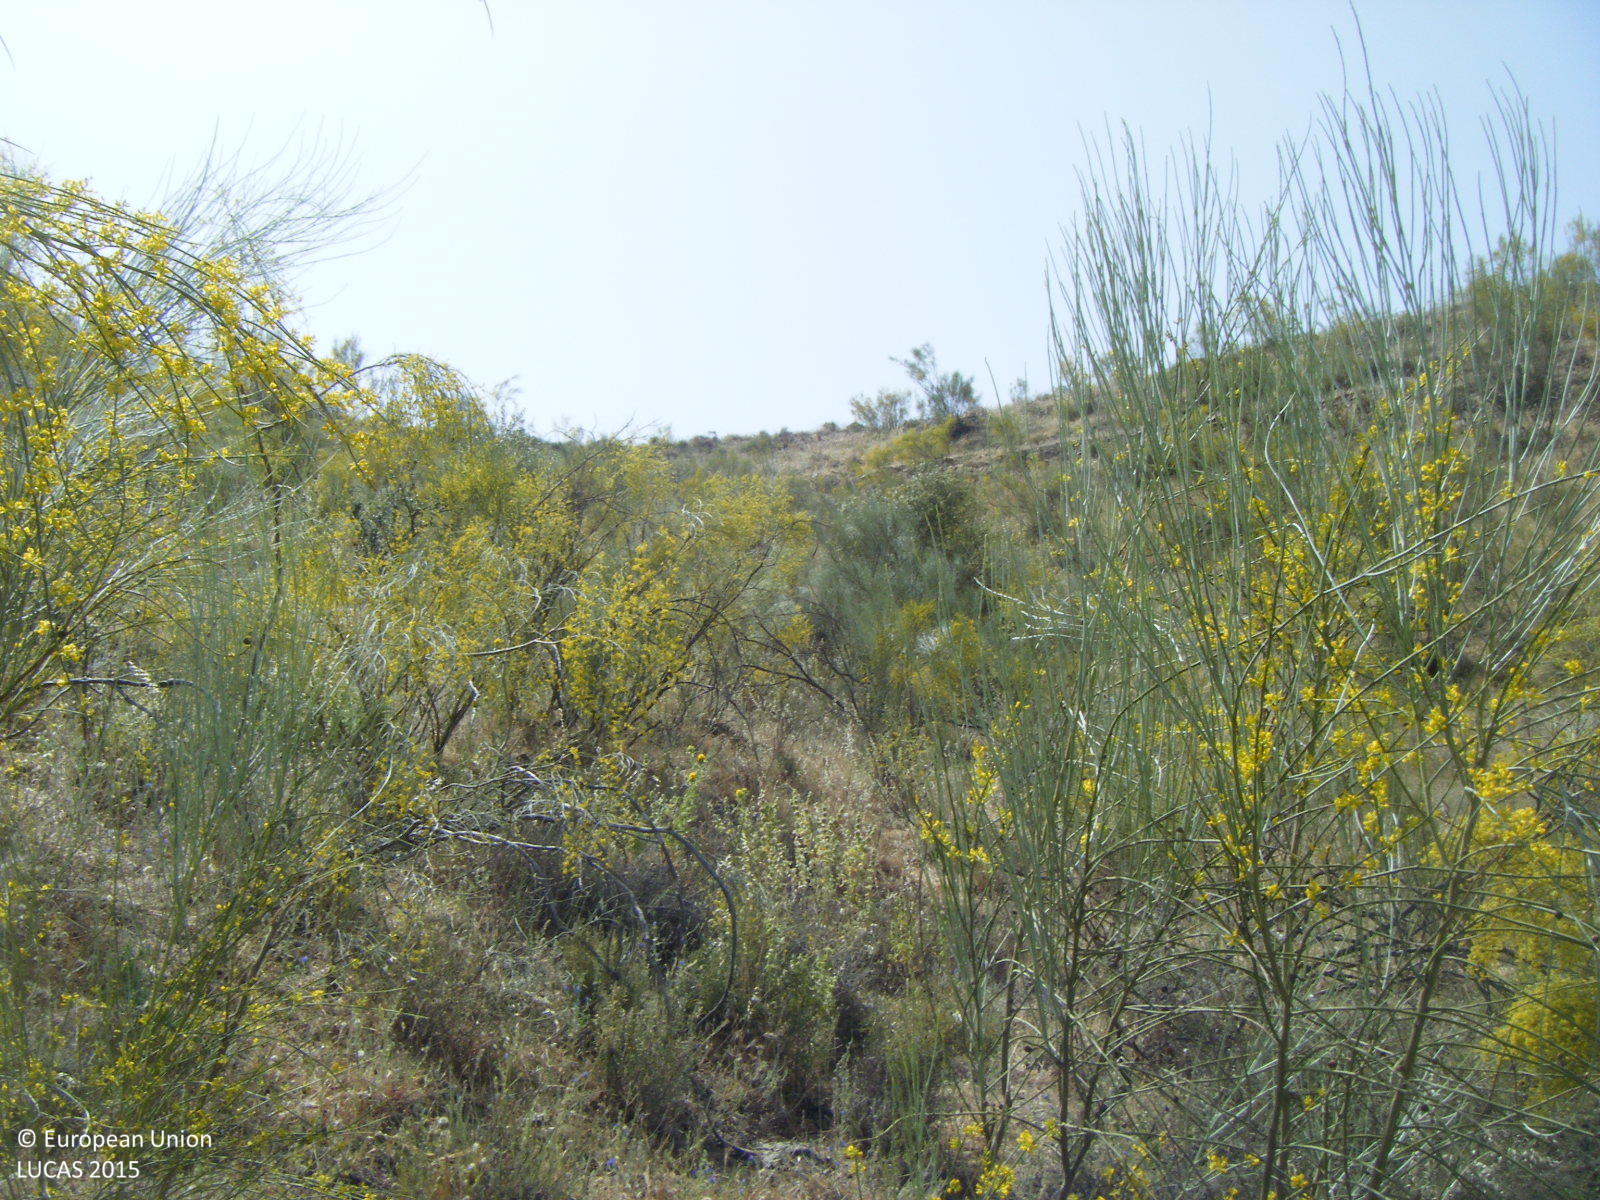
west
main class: Shrubland
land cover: Shrubland without tree cover
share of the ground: 50 - 75 %
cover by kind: shrubs 50 %, herbaceous plants 50 %
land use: Semi-natural and natural areas not in use
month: May
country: ES
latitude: 36.7639
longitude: -4.2269
